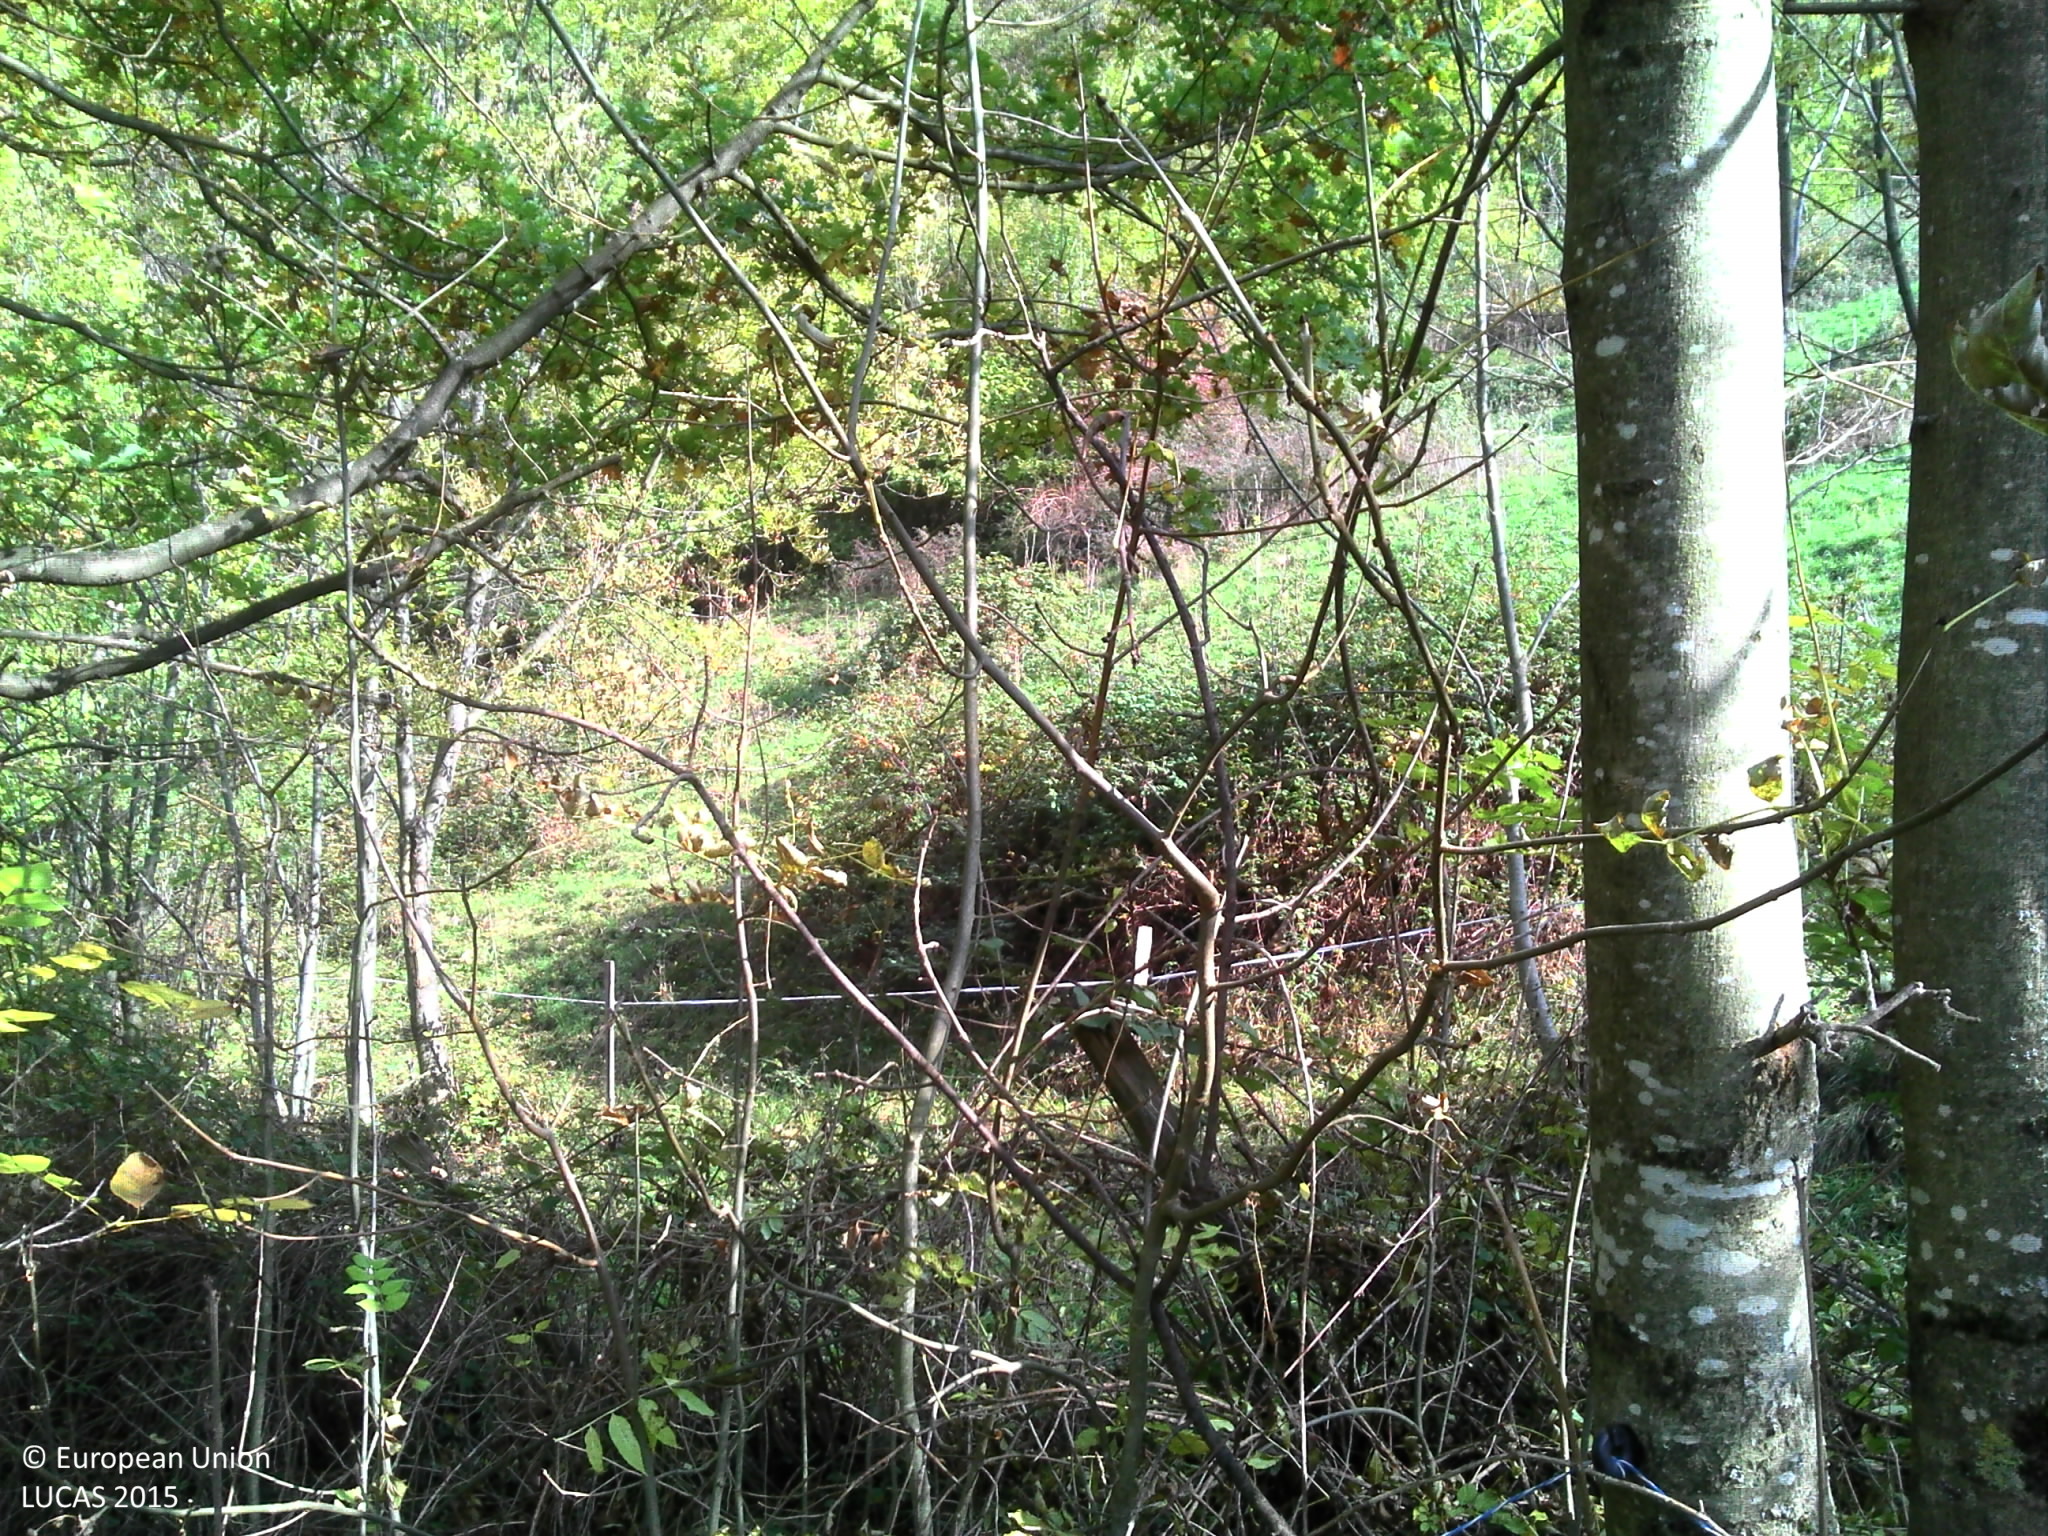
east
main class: Woodland
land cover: Broadleaved woodland
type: mesophytic deciduous forest
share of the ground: > 75 %
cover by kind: broadleaved forest trees 90 %, shrubs 5 %, consolidated bare surface 5 %
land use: Forestry
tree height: > 5 m
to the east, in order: Broadleaved woodland; Fences; Tracks; Lines of trees; Fences; Shrubland with sparse tree cover; Broadleaved woodland; Grassland with sparse tree/shrub cover; Fences; Broadleaved woodland; Spruce dominated mixed woodland
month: October
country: FR
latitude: 45.4031
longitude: 6.2871
